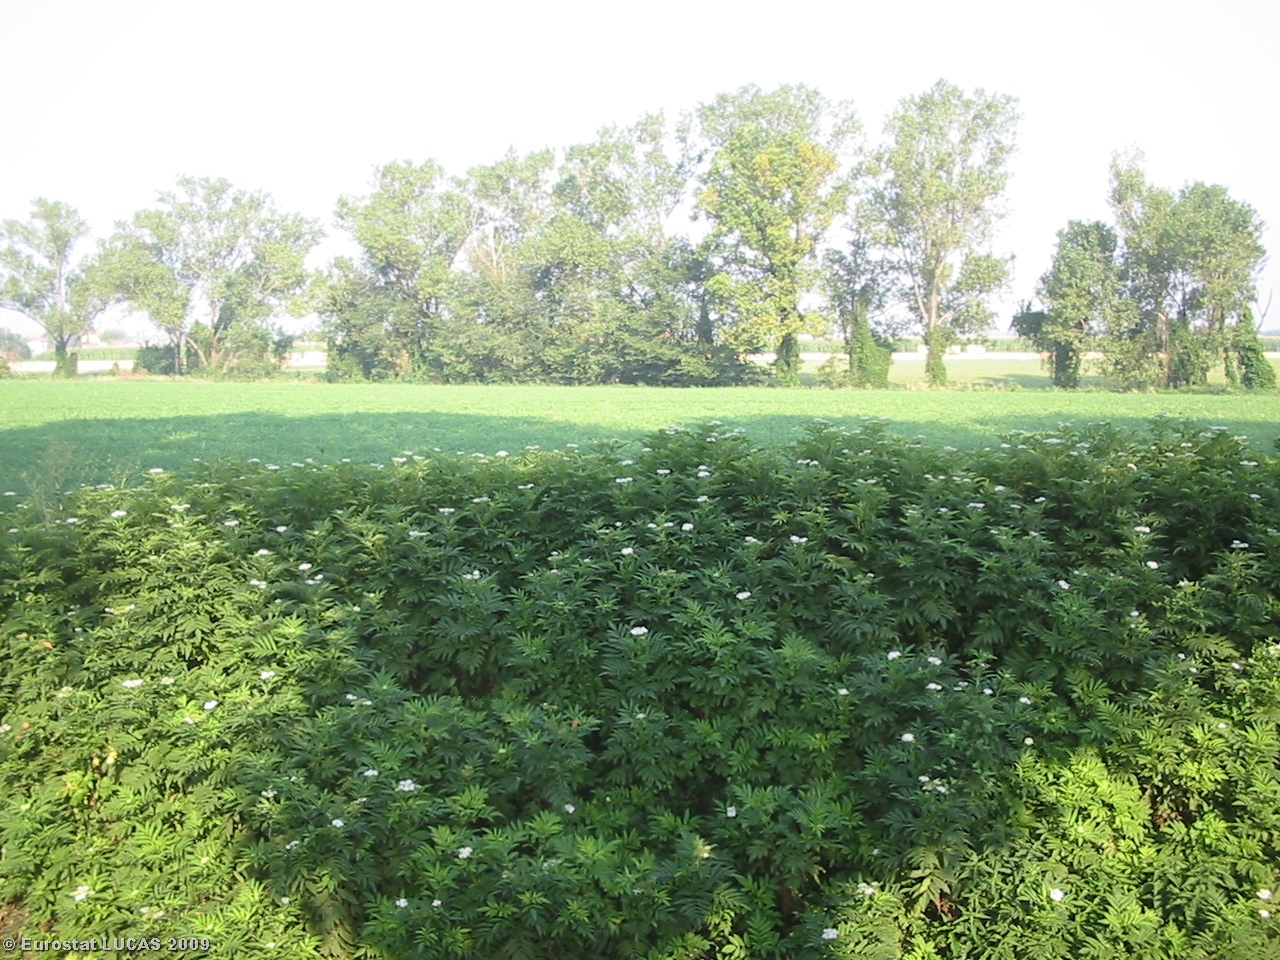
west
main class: Cropland
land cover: Lucerne
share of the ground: > 75 %
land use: Agriculture (excluding fallow land and kitchen gardens)
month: July
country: IT
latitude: 44.7468
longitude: 10.3151
